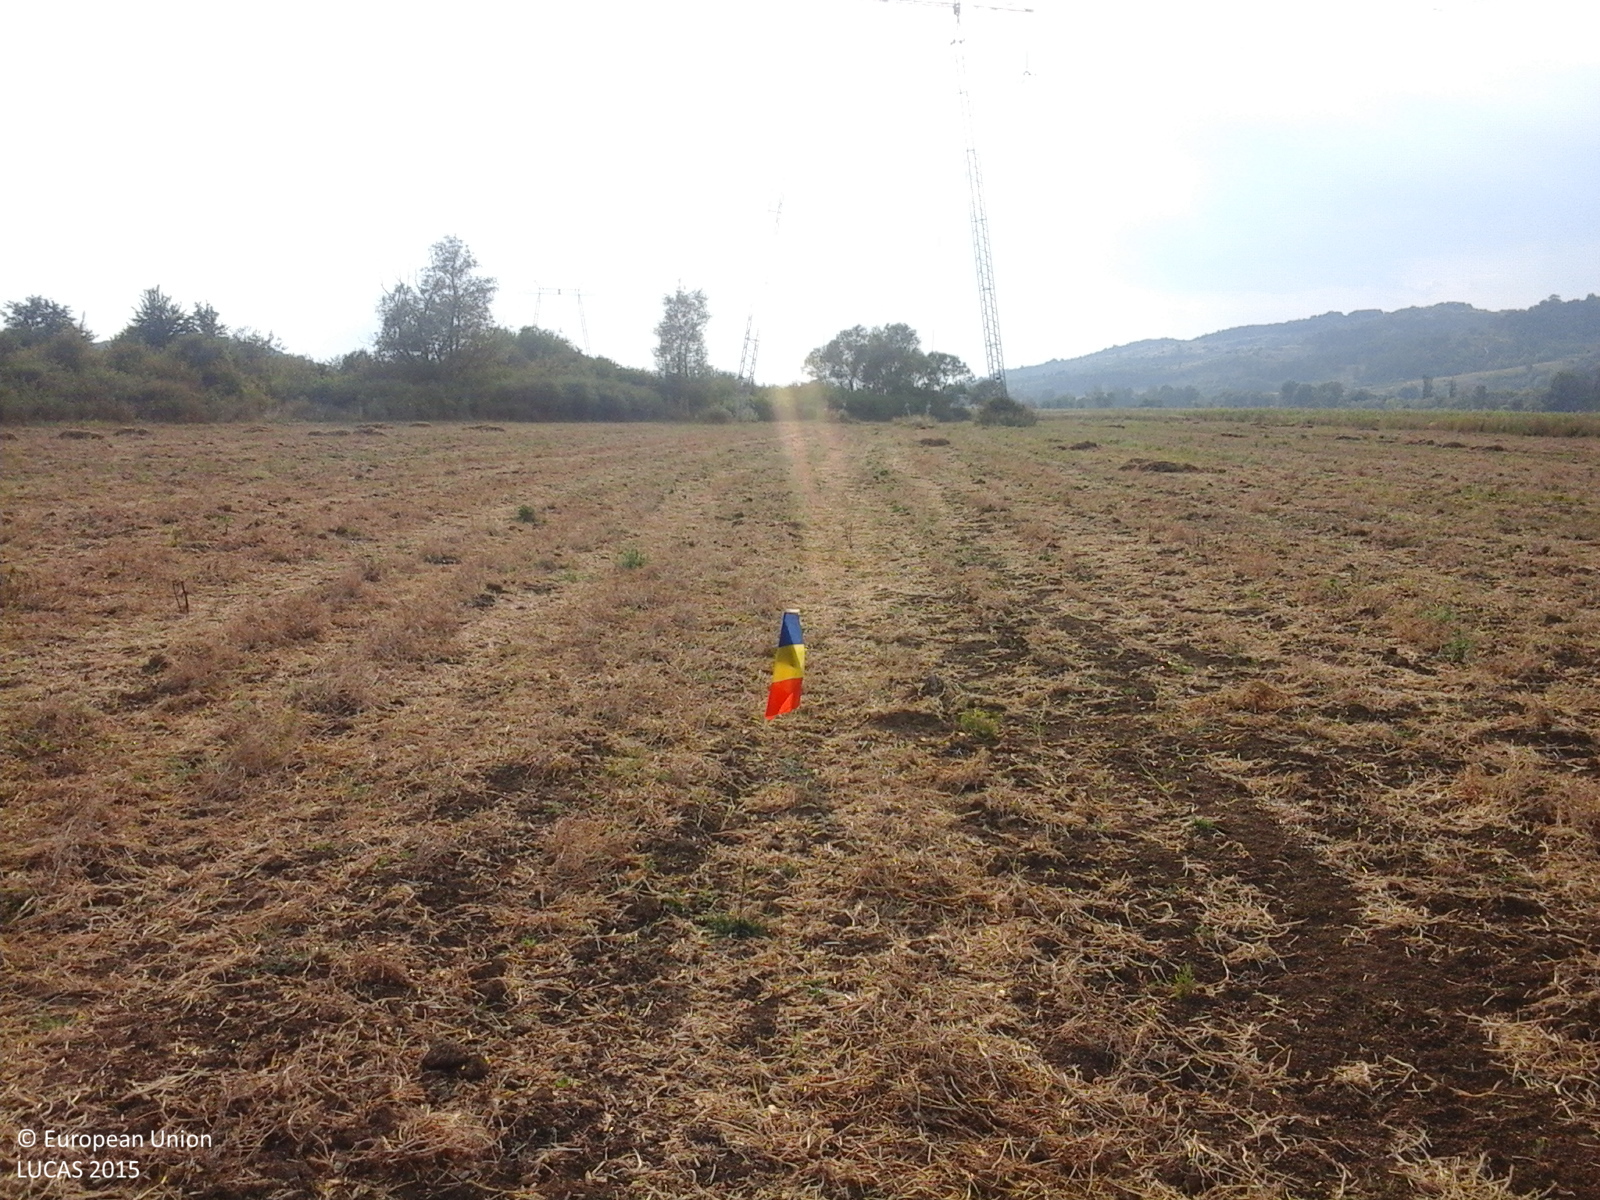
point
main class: Grassland
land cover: Spontaneously vegetated surfaces
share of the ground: > 75 %
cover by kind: herbaceous plants 100 %
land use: Fallow land
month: August
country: RO
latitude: 44.5863
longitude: 23.0071
